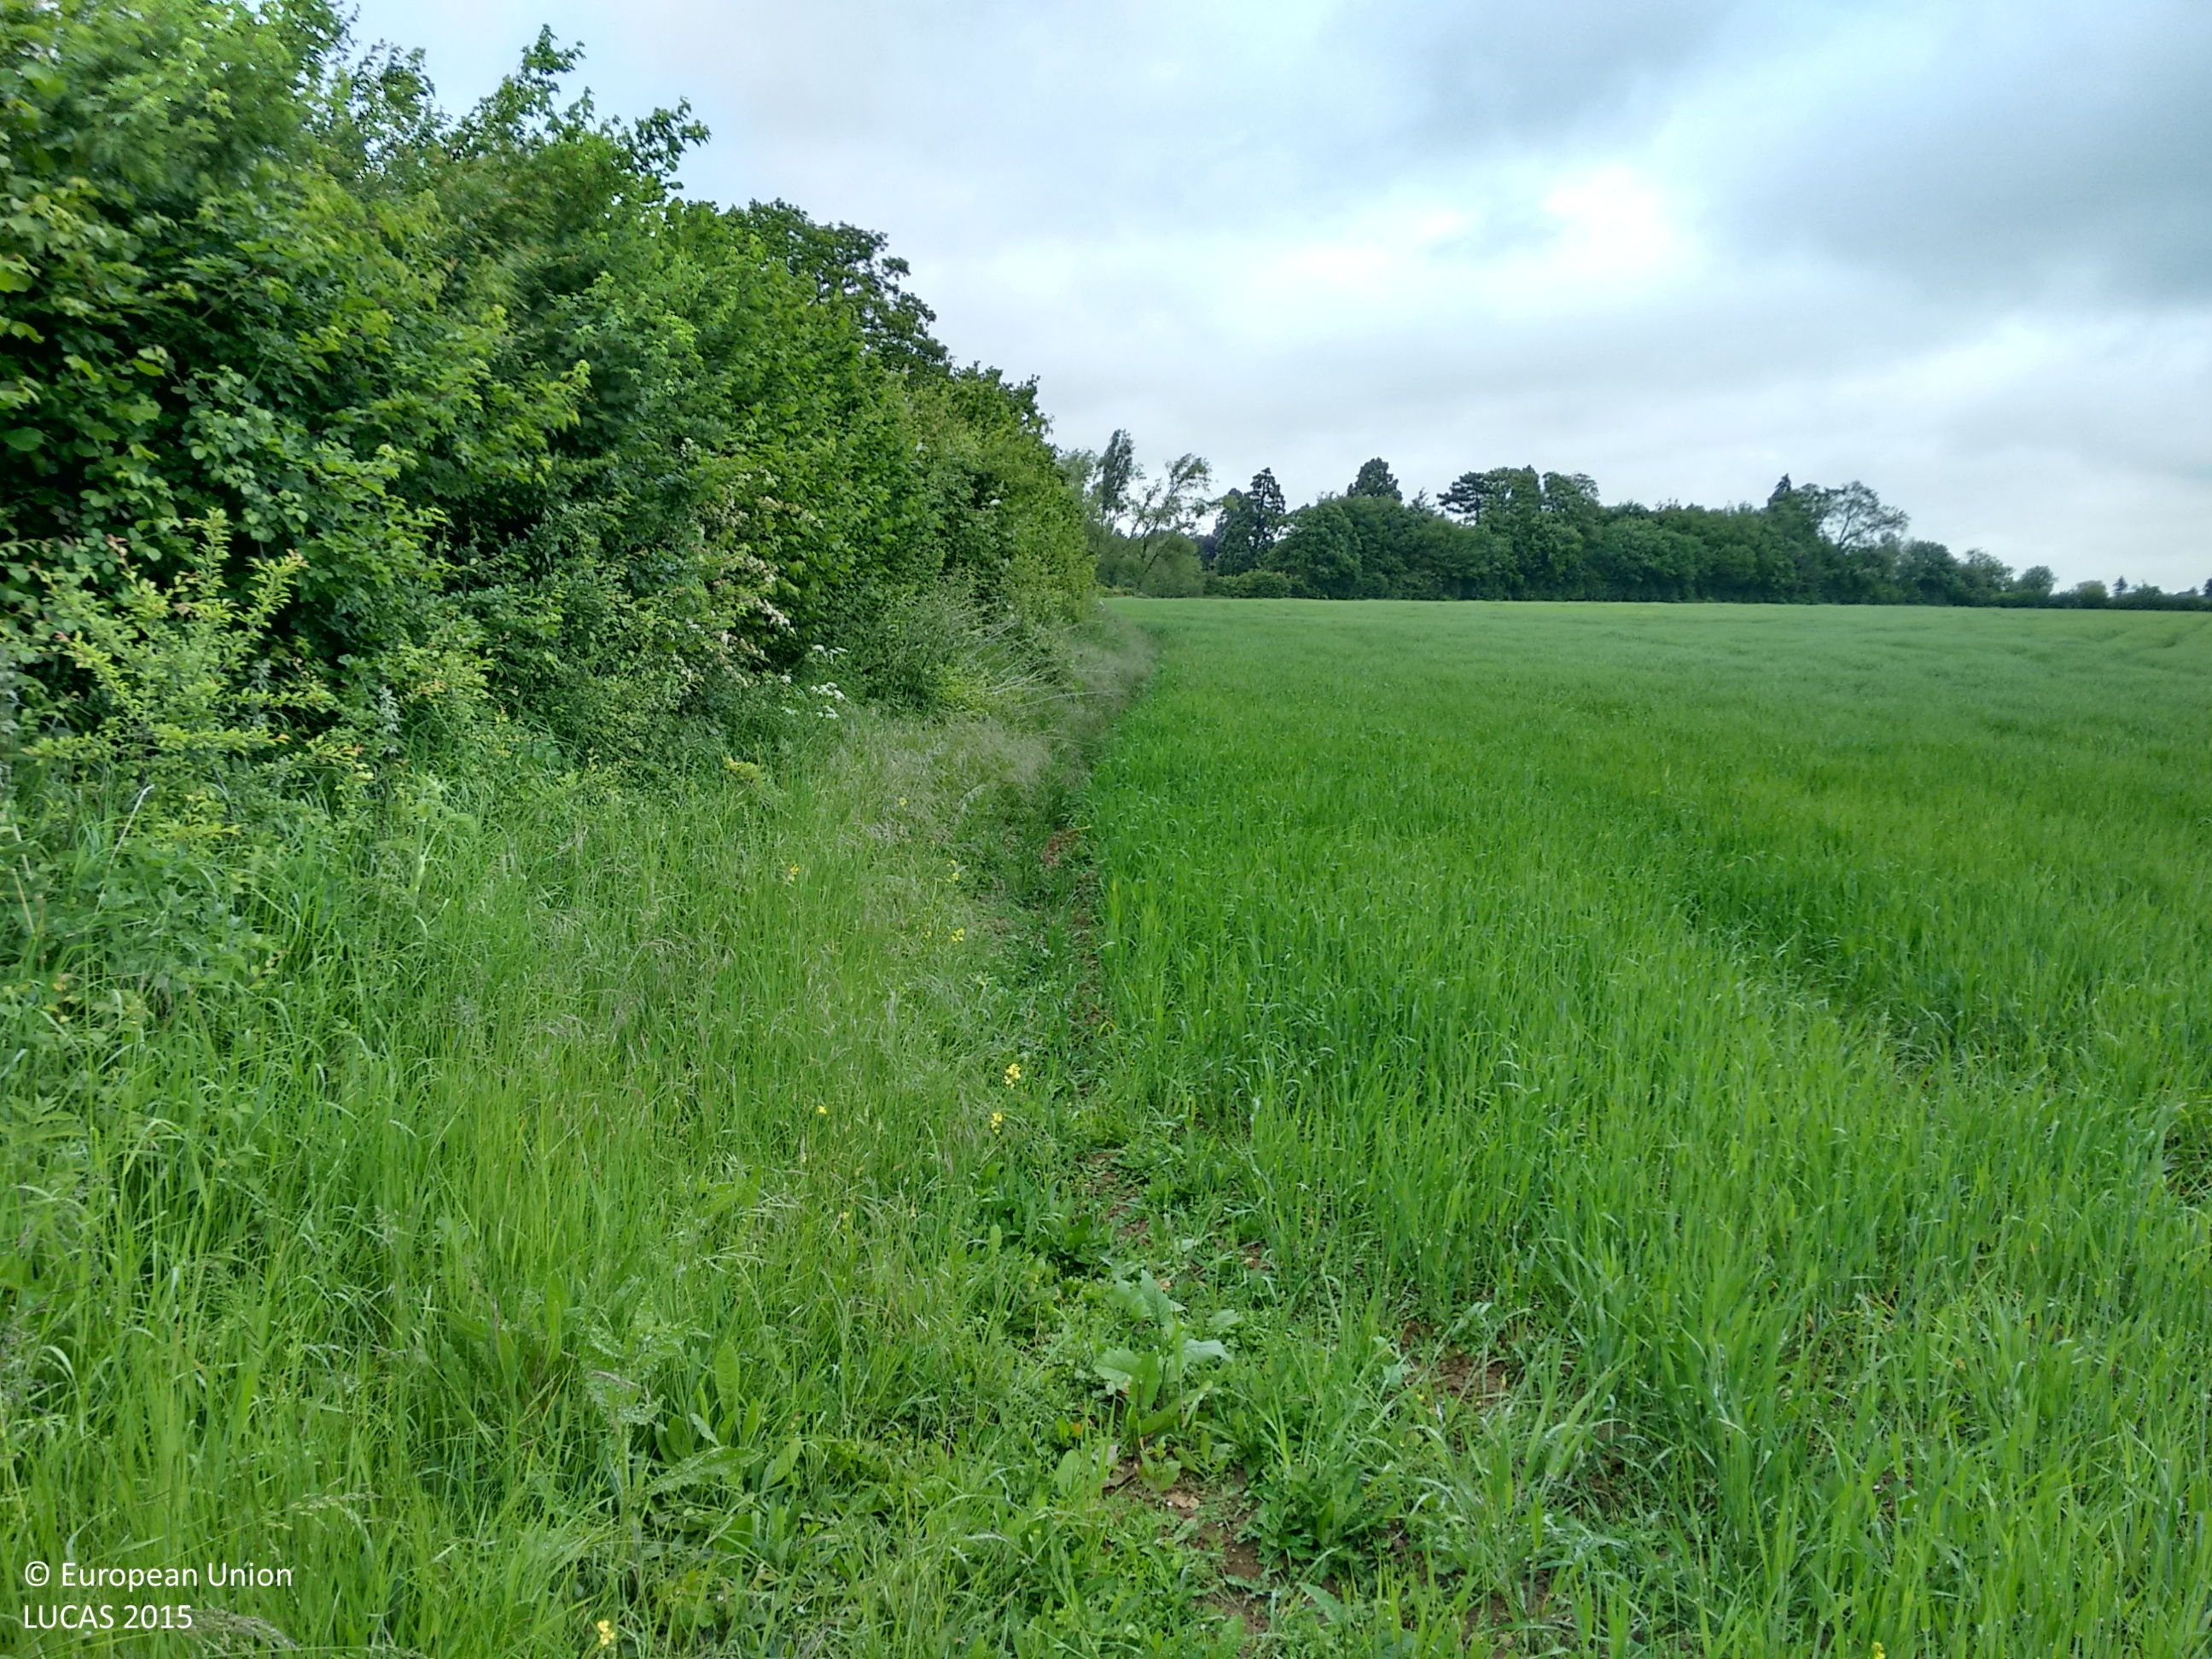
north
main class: Cropland
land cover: Barley
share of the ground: > 75 %
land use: Agriculture (excluding fallow land and kitchen gardens)
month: June
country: GB
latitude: 51.8015
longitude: 0.1219
